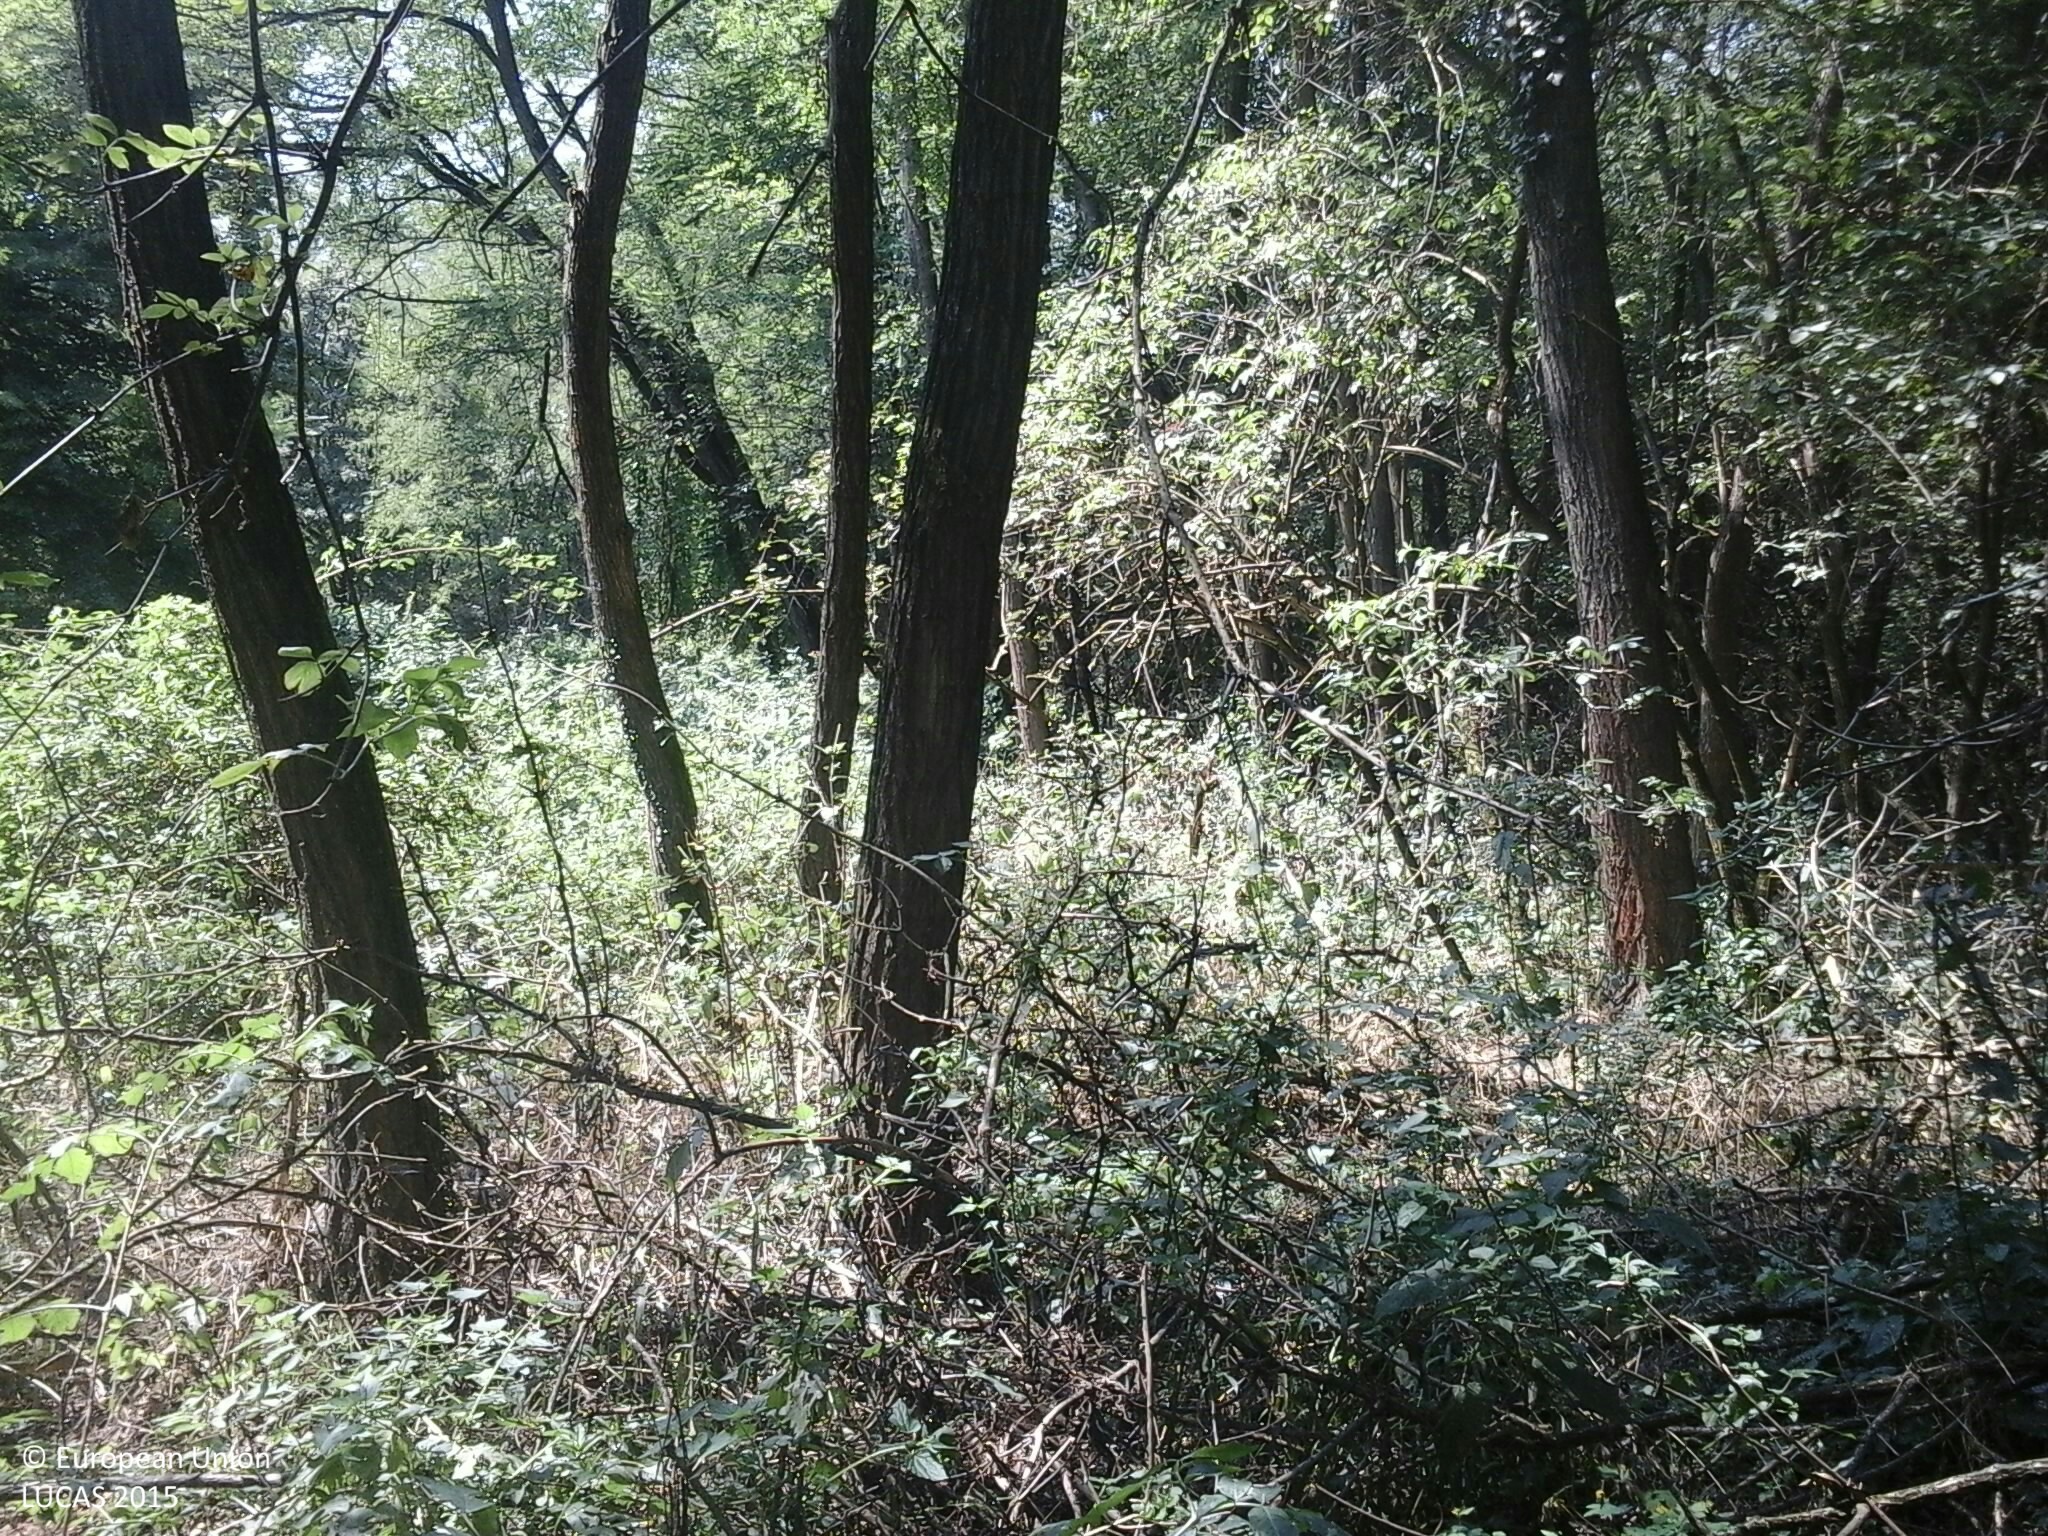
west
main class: Woodland
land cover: Broadleaved woodland
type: mesophytic deciduous forest
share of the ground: > 75 %
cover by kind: broadleaved forest trees 100 %
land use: Forestry
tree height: > 5 m
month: August
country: HU
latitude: 46.1722
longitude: 18.0762
